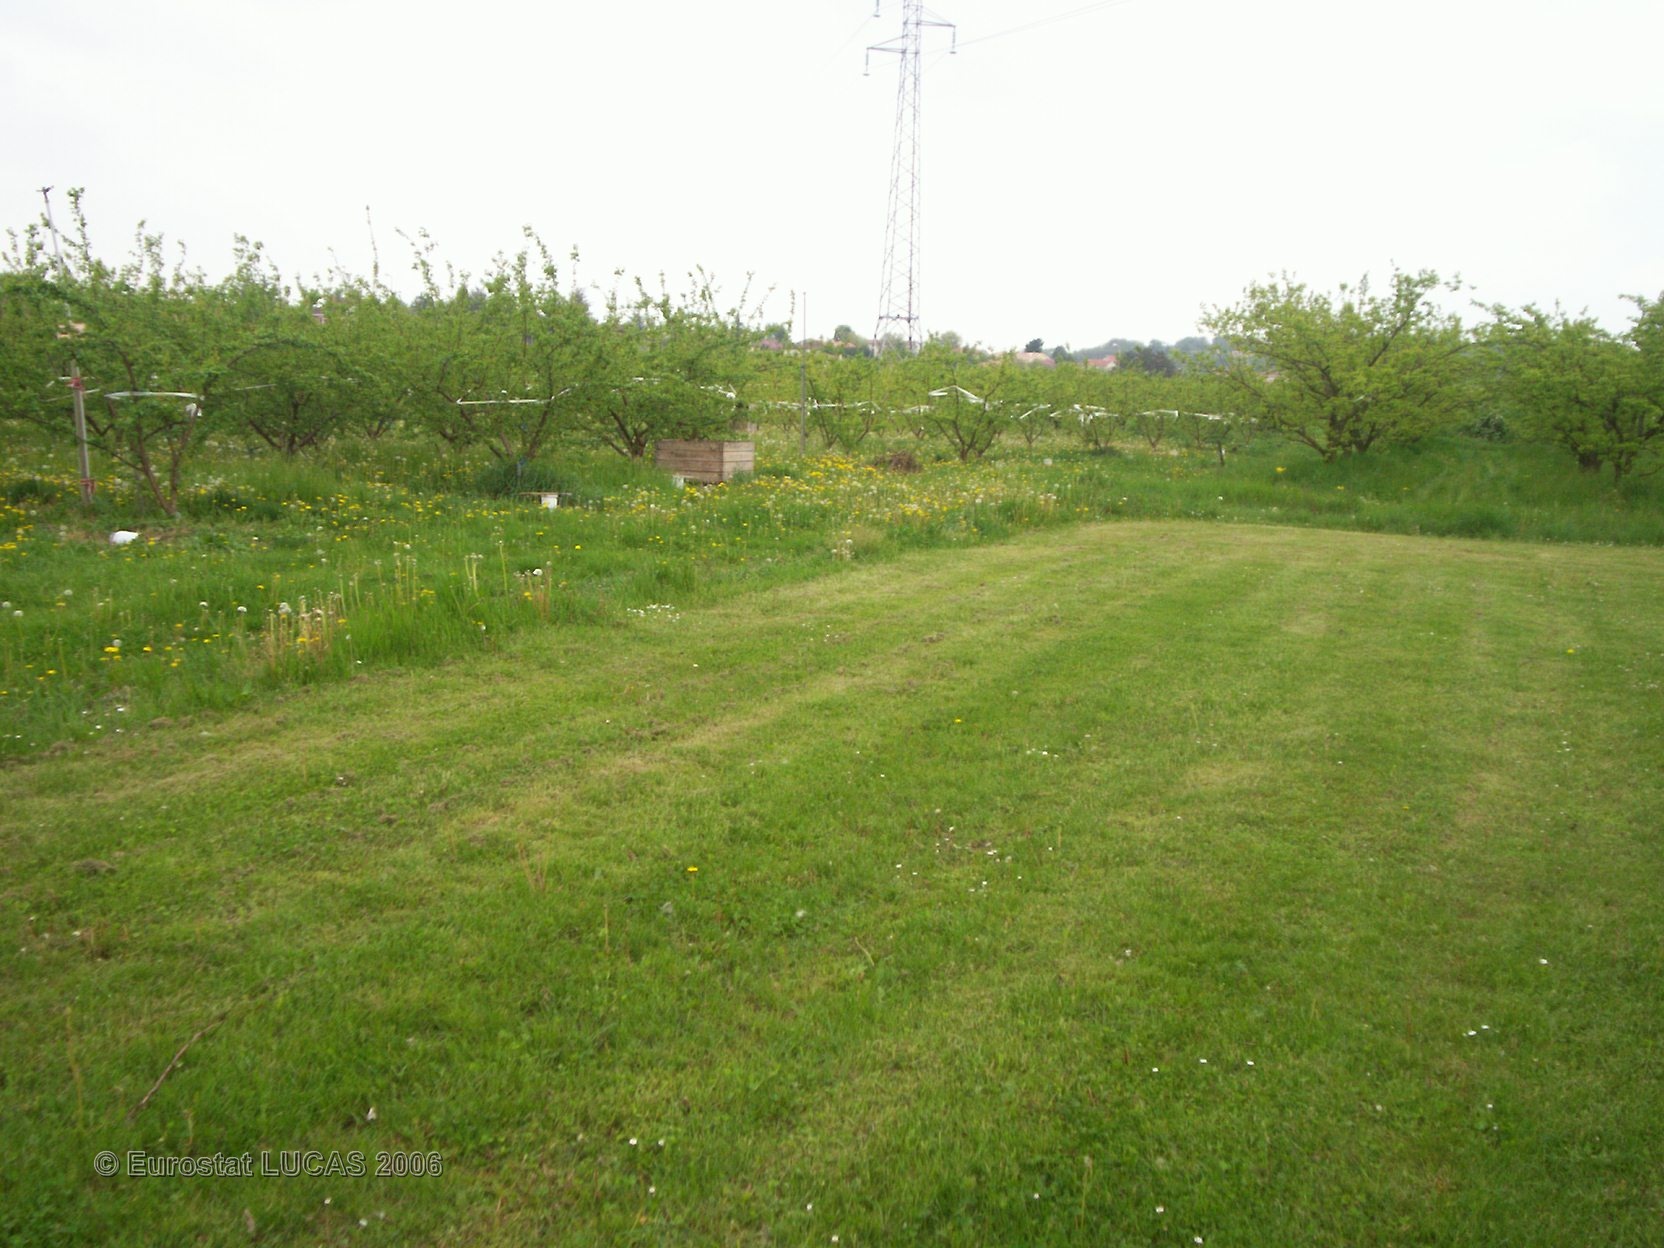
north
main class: Grassland
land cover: Grassland with sparse tree/shrub cover
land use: Amenities, museums, leisure
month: April
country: FR
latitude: 45.3407
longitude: 4.8106
